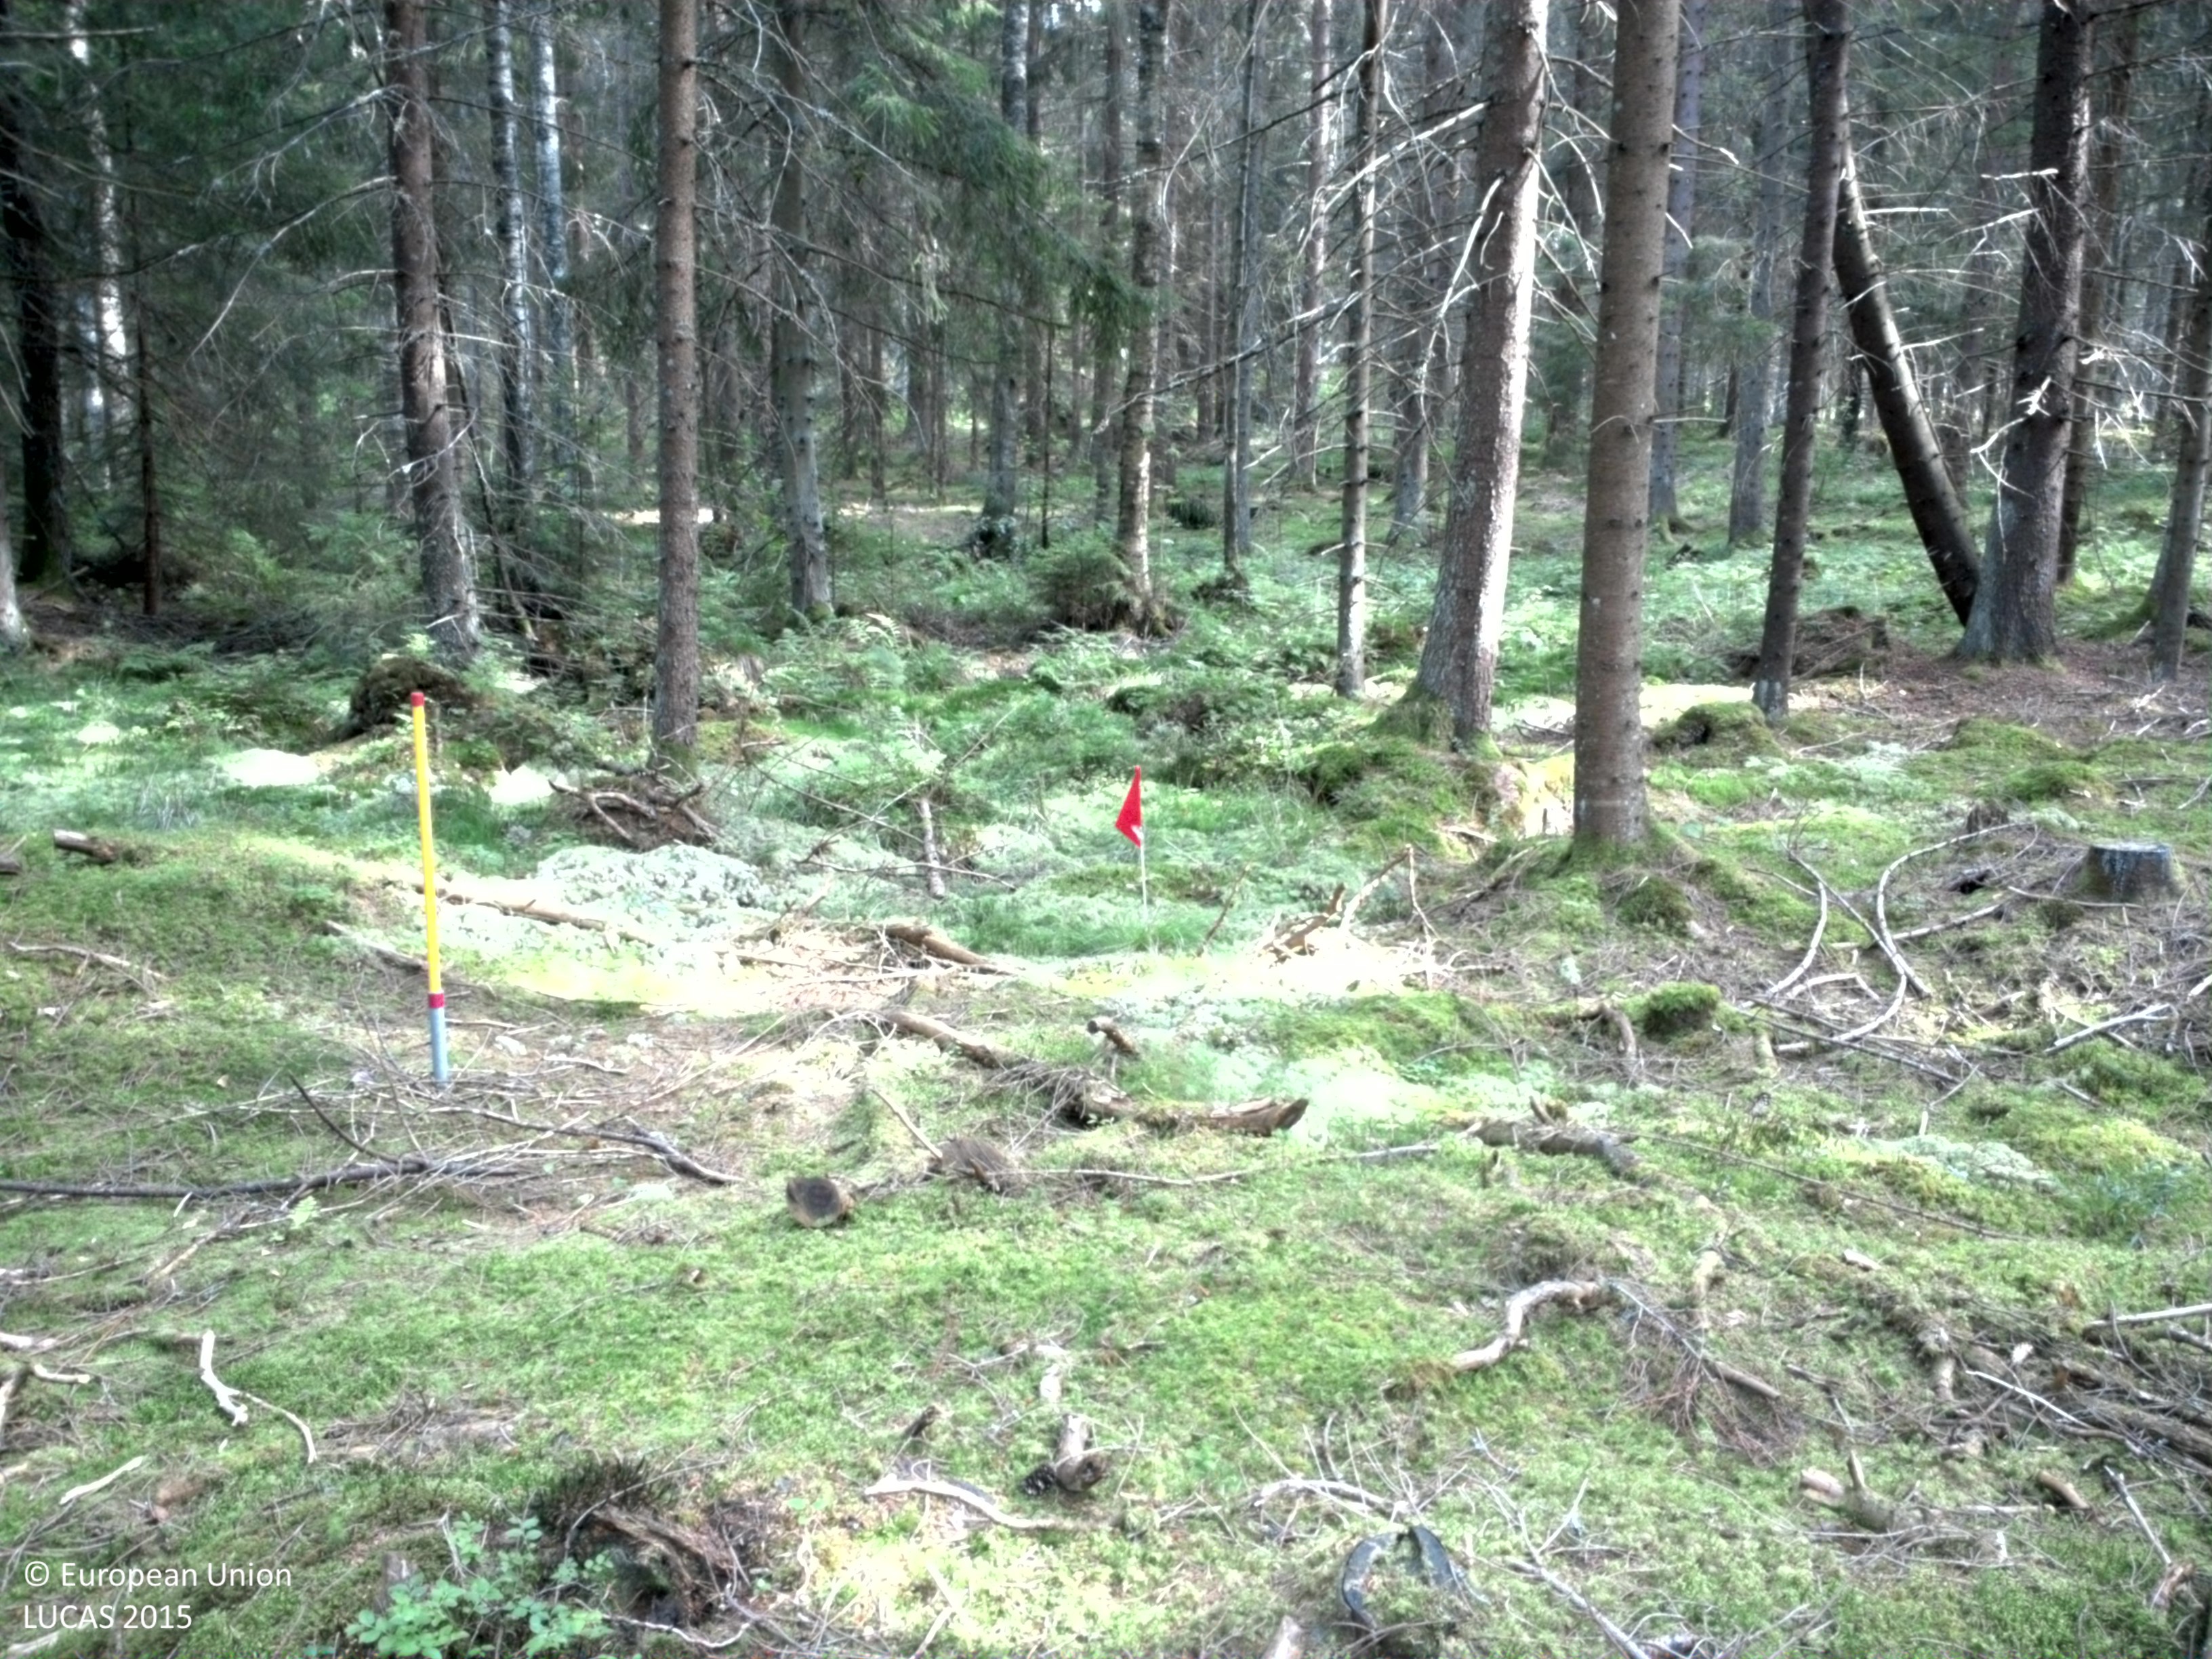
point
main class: Woodland
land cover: Spruce dominated coniferous woodland
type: boreal forest
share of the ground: 50 - 75 %
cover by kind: coniferous forest trees 55 %, lichens and mosses 35 %, shrubs 5 %, herbaceous plants 5 %
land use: Forestry
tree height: > 5 m
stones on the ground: < 10 %
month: August
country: SE
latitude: 58.7888
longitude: 14.0588
